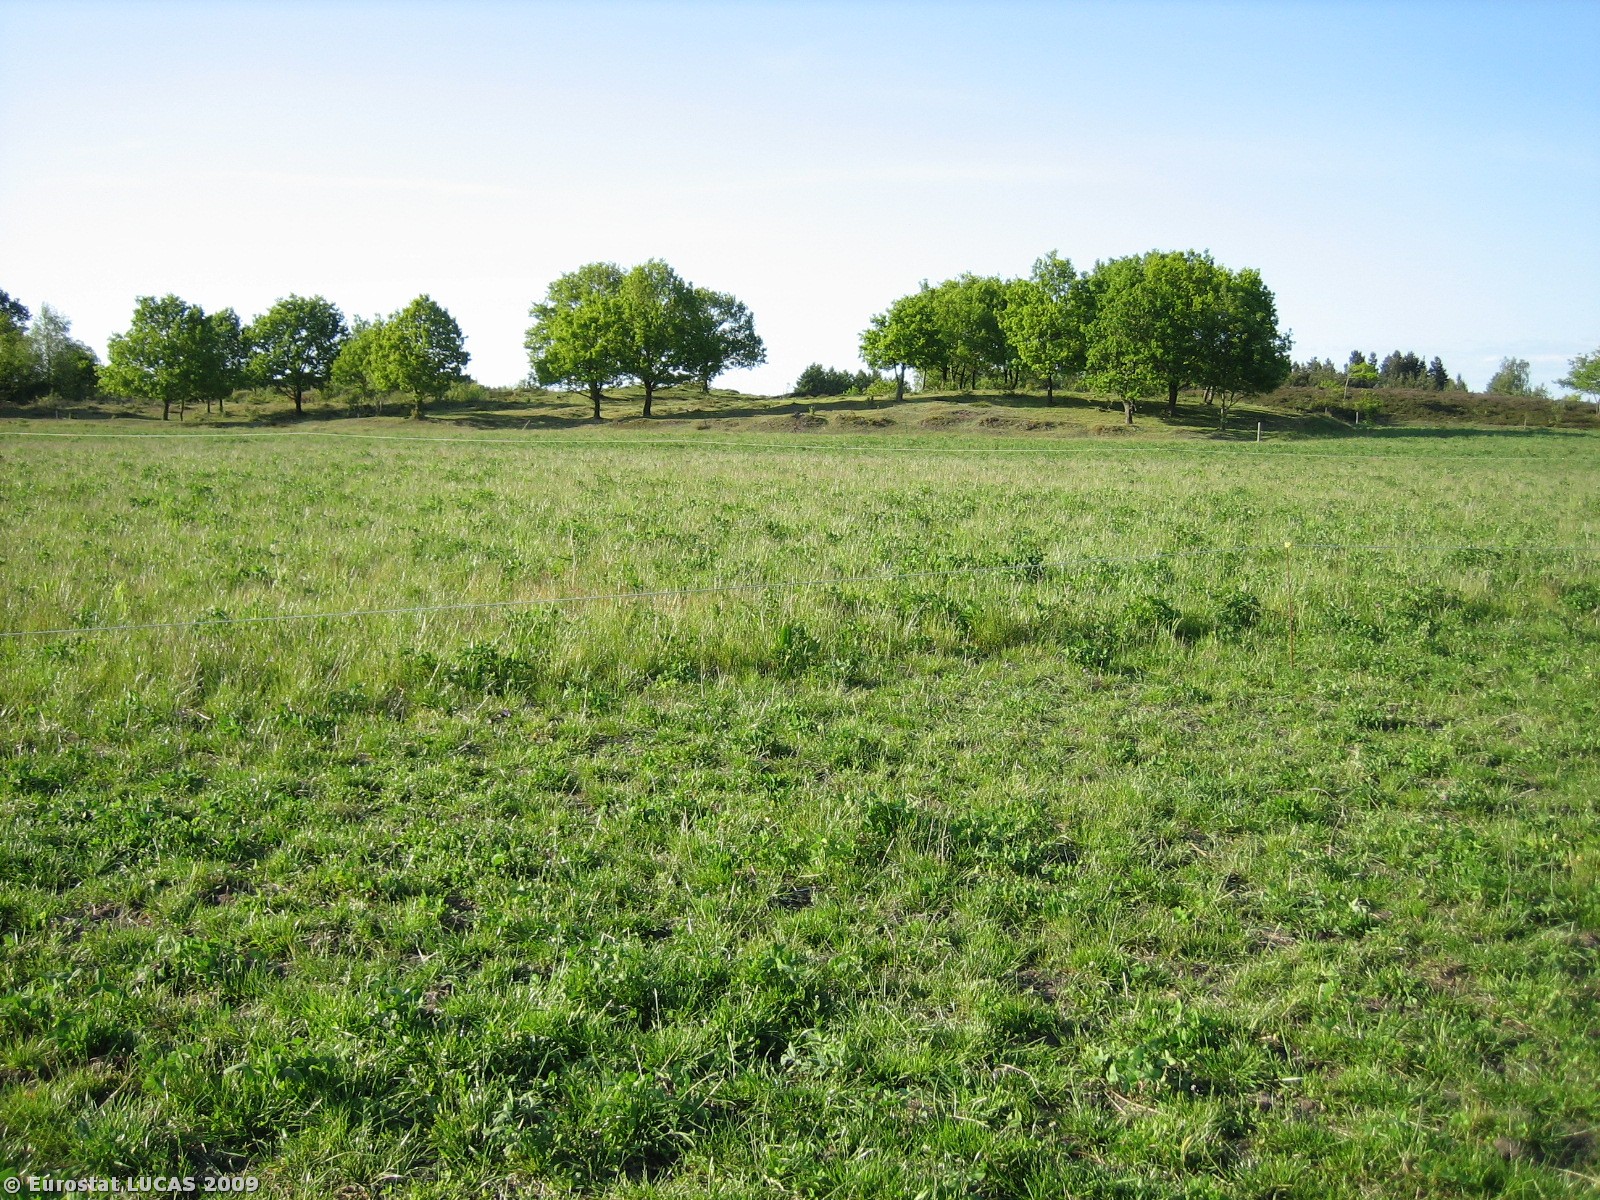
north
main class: Grassland
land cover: Grassland without tree/shrub cover
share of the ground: > 75 %
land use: Agriculture (excluding fallow land and kitchen gardens)
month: May
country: DK
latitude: 55.8422
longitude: 8.9950
